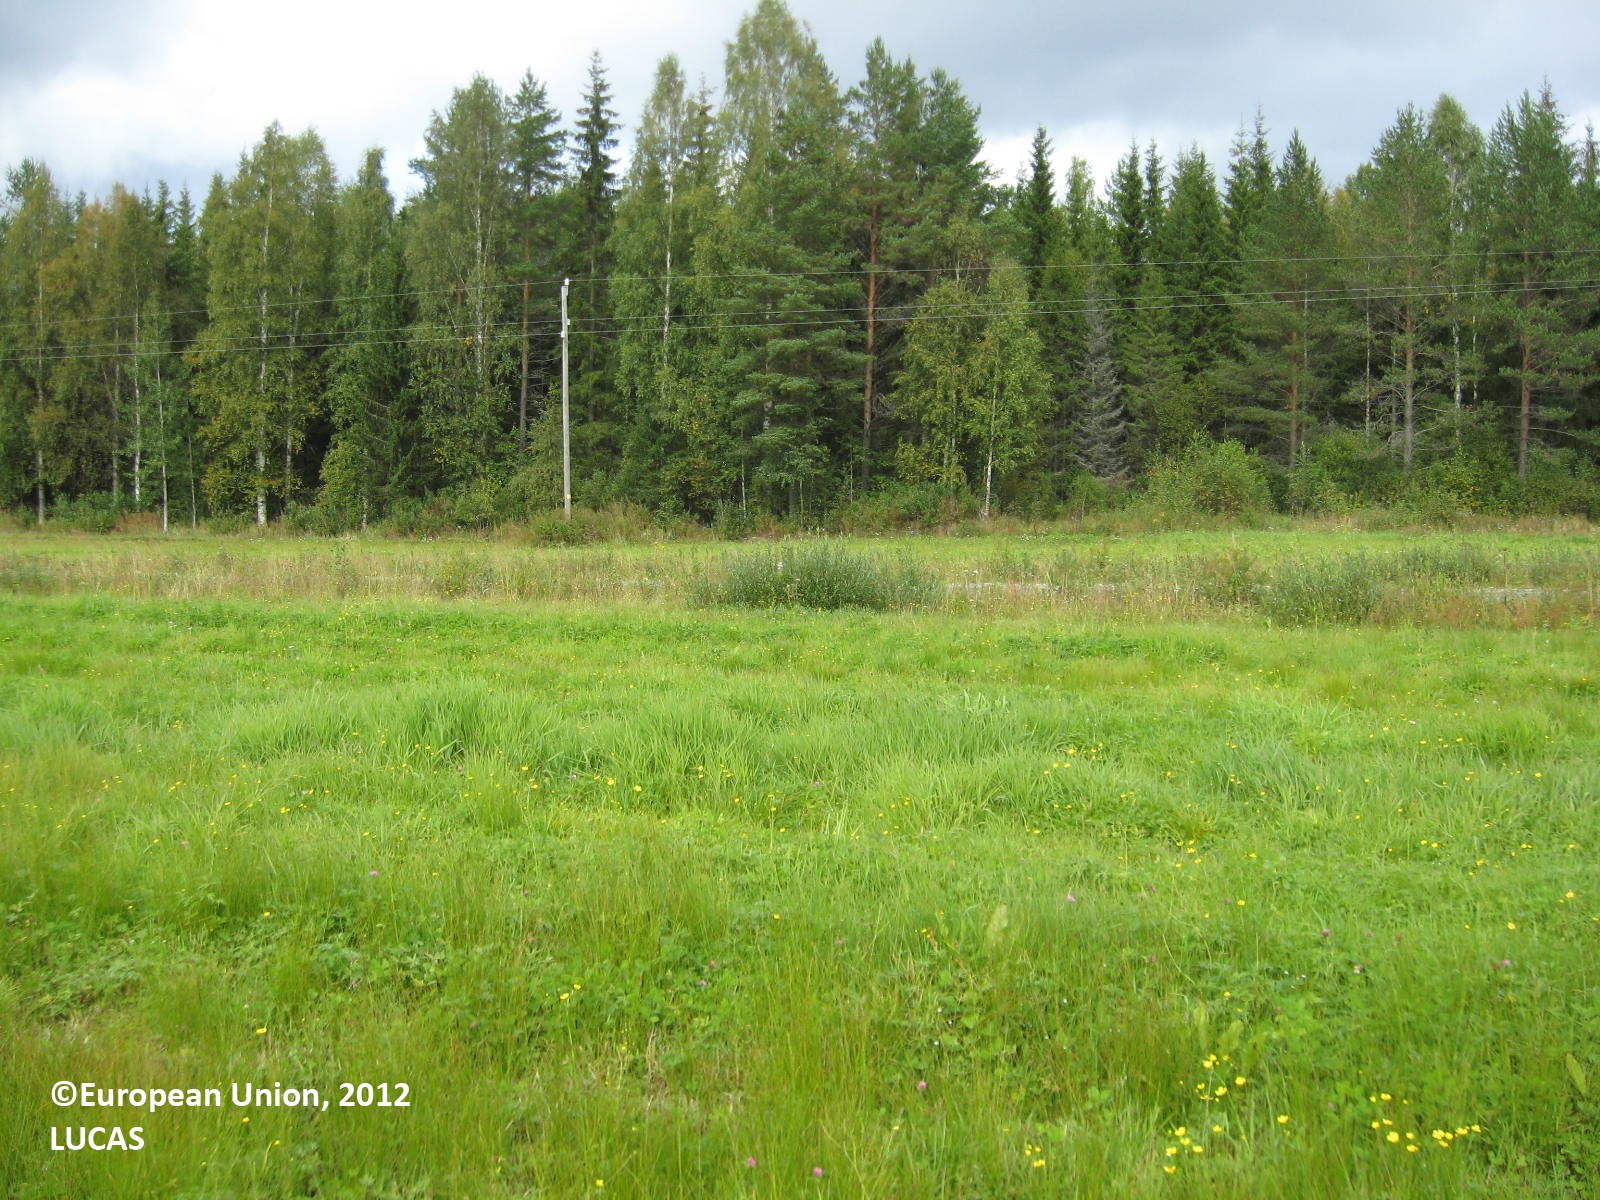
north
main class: Cropland
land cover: Temporary grasslands
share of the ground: > 75 %
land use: Agriculture (excluding fallow land and kitchen gardens)
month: August
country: FI
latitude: 63.5917
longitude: 29.2605
